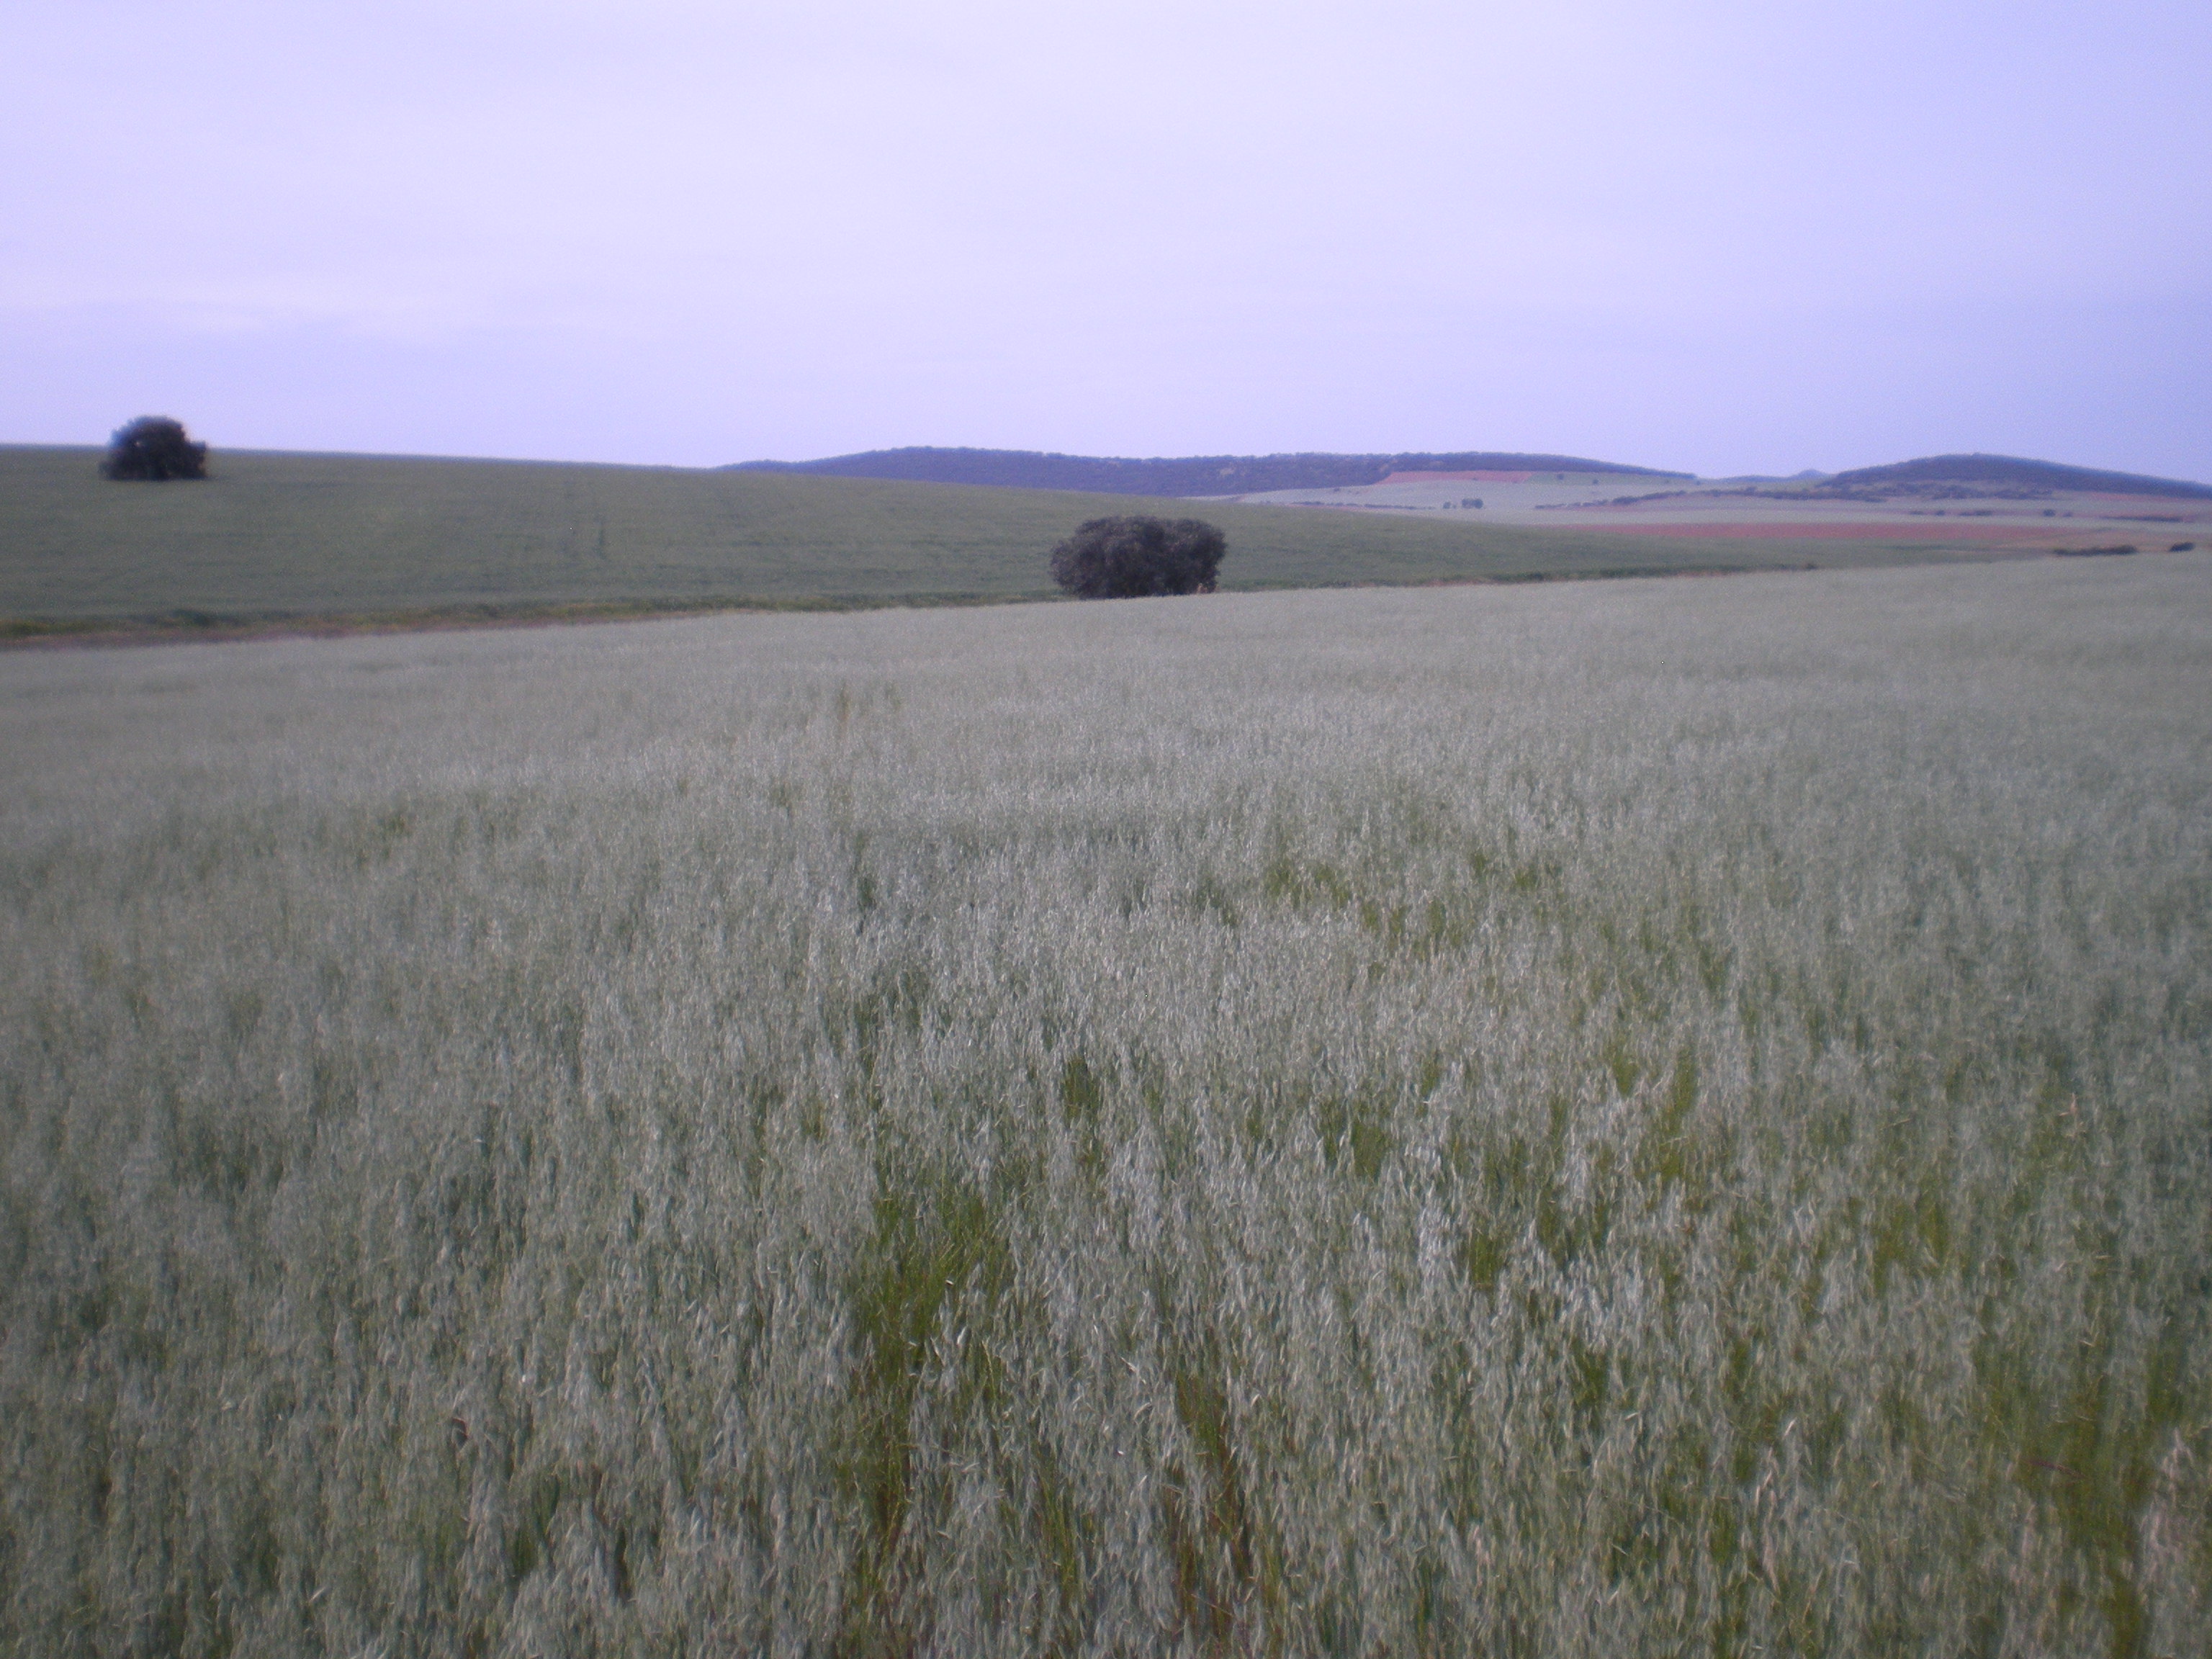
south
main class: Cropland
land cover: Oats
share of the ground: > 75 %
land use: Agriculture (excluding fallow land and kitchen gardens)
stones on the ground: 10 - 25 %
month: May
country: ES
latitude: 38.6468
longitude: -3.1396
